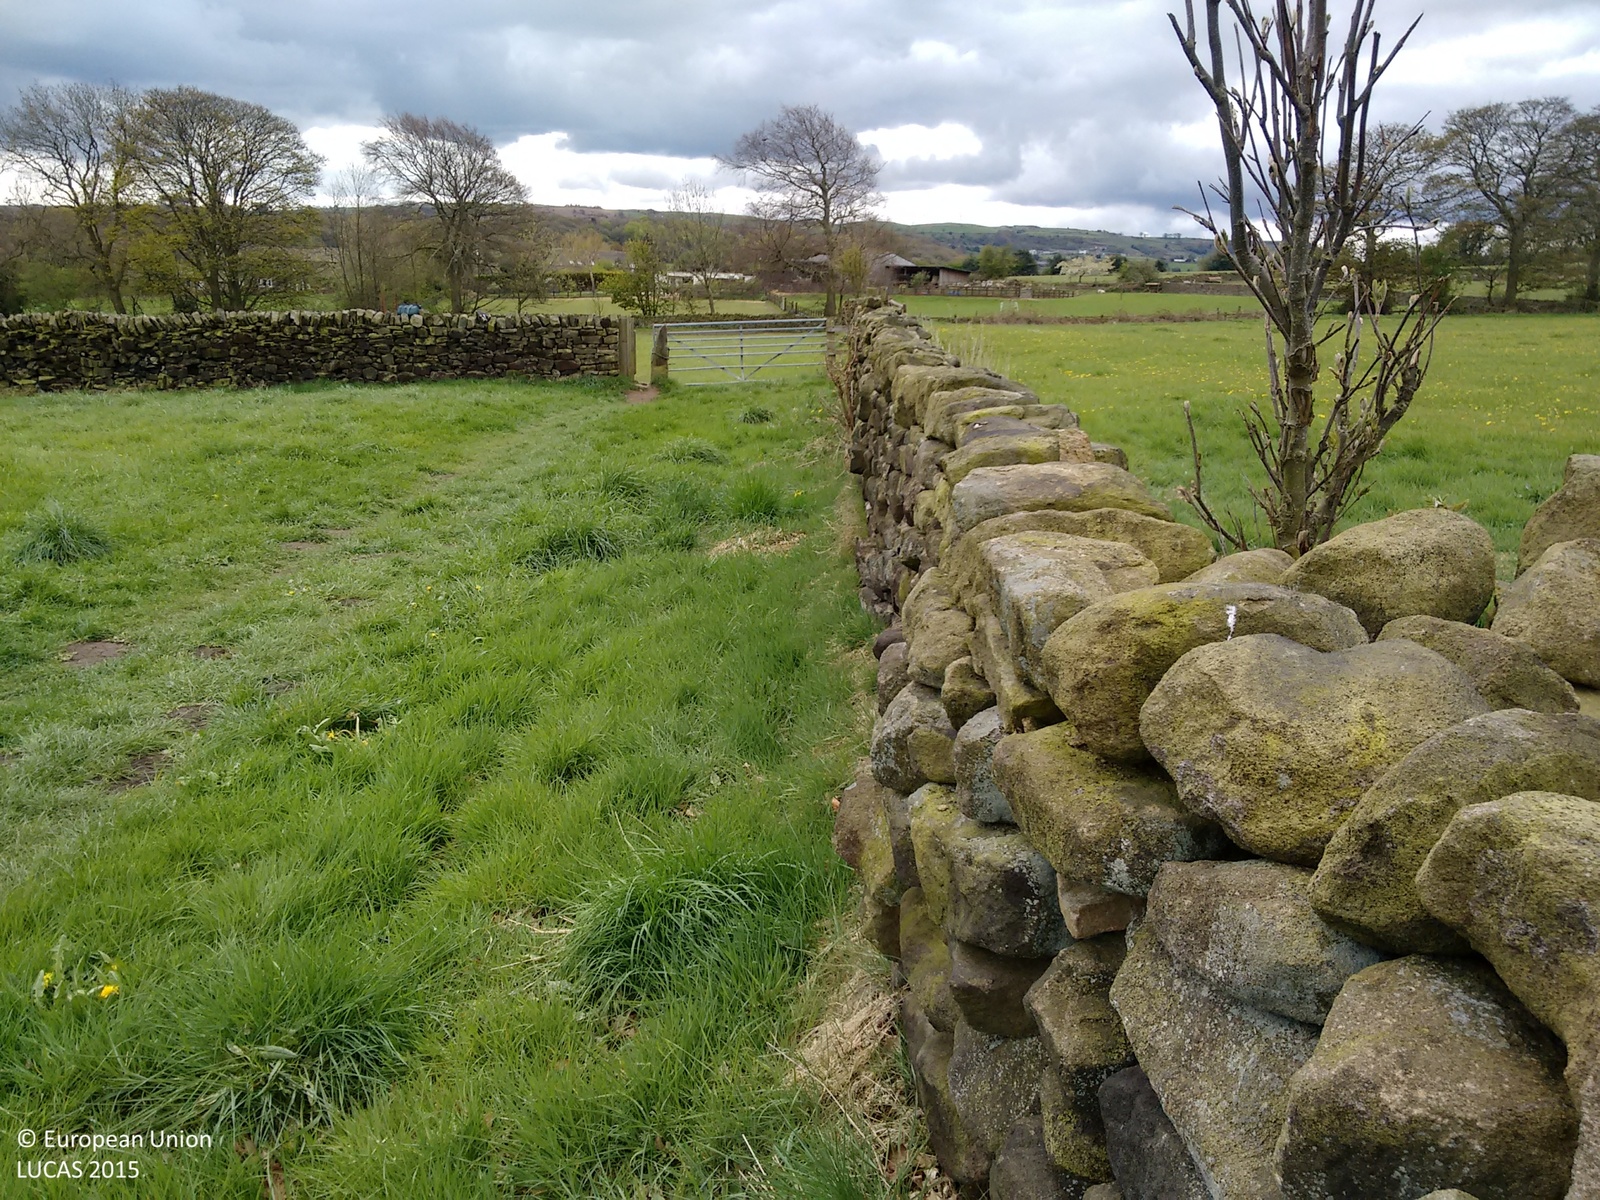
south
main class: Grassland
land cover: Grassland without tree/shrub cover
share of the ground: > 75 %
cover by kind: herbaceous plants 100 %
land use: Agriculture (excluding fallow land and kitchen gardens)
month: April
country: GB
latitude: 53.5927
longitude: -1.7321
